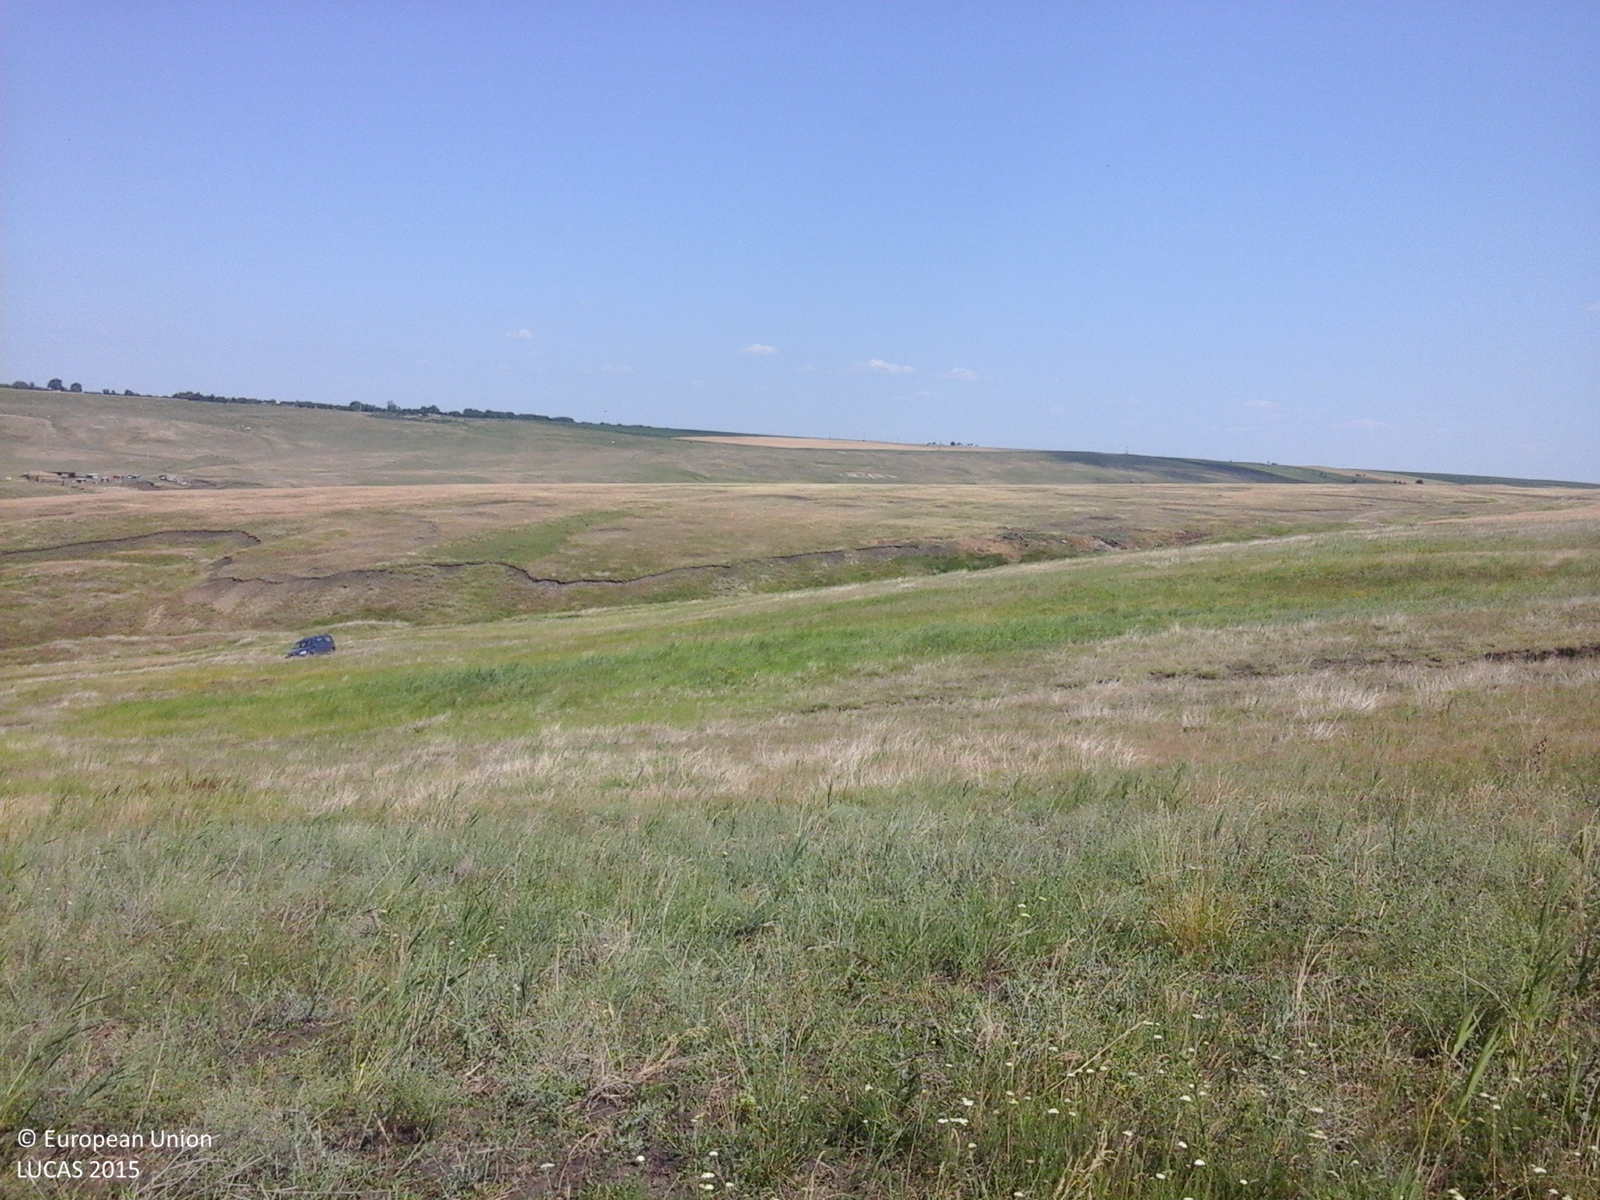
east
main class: Grassland
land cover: Spontaneously vegetated surfaces
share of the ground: > 75 %
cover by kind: herbaceous plants 100 %
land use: Fallow land
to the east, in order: Spontaneously vegetated surfaces; Ditches and canals; Grassland without tree/shrub cover
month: June
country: RO
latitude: 47.2732
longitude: 27.3626
